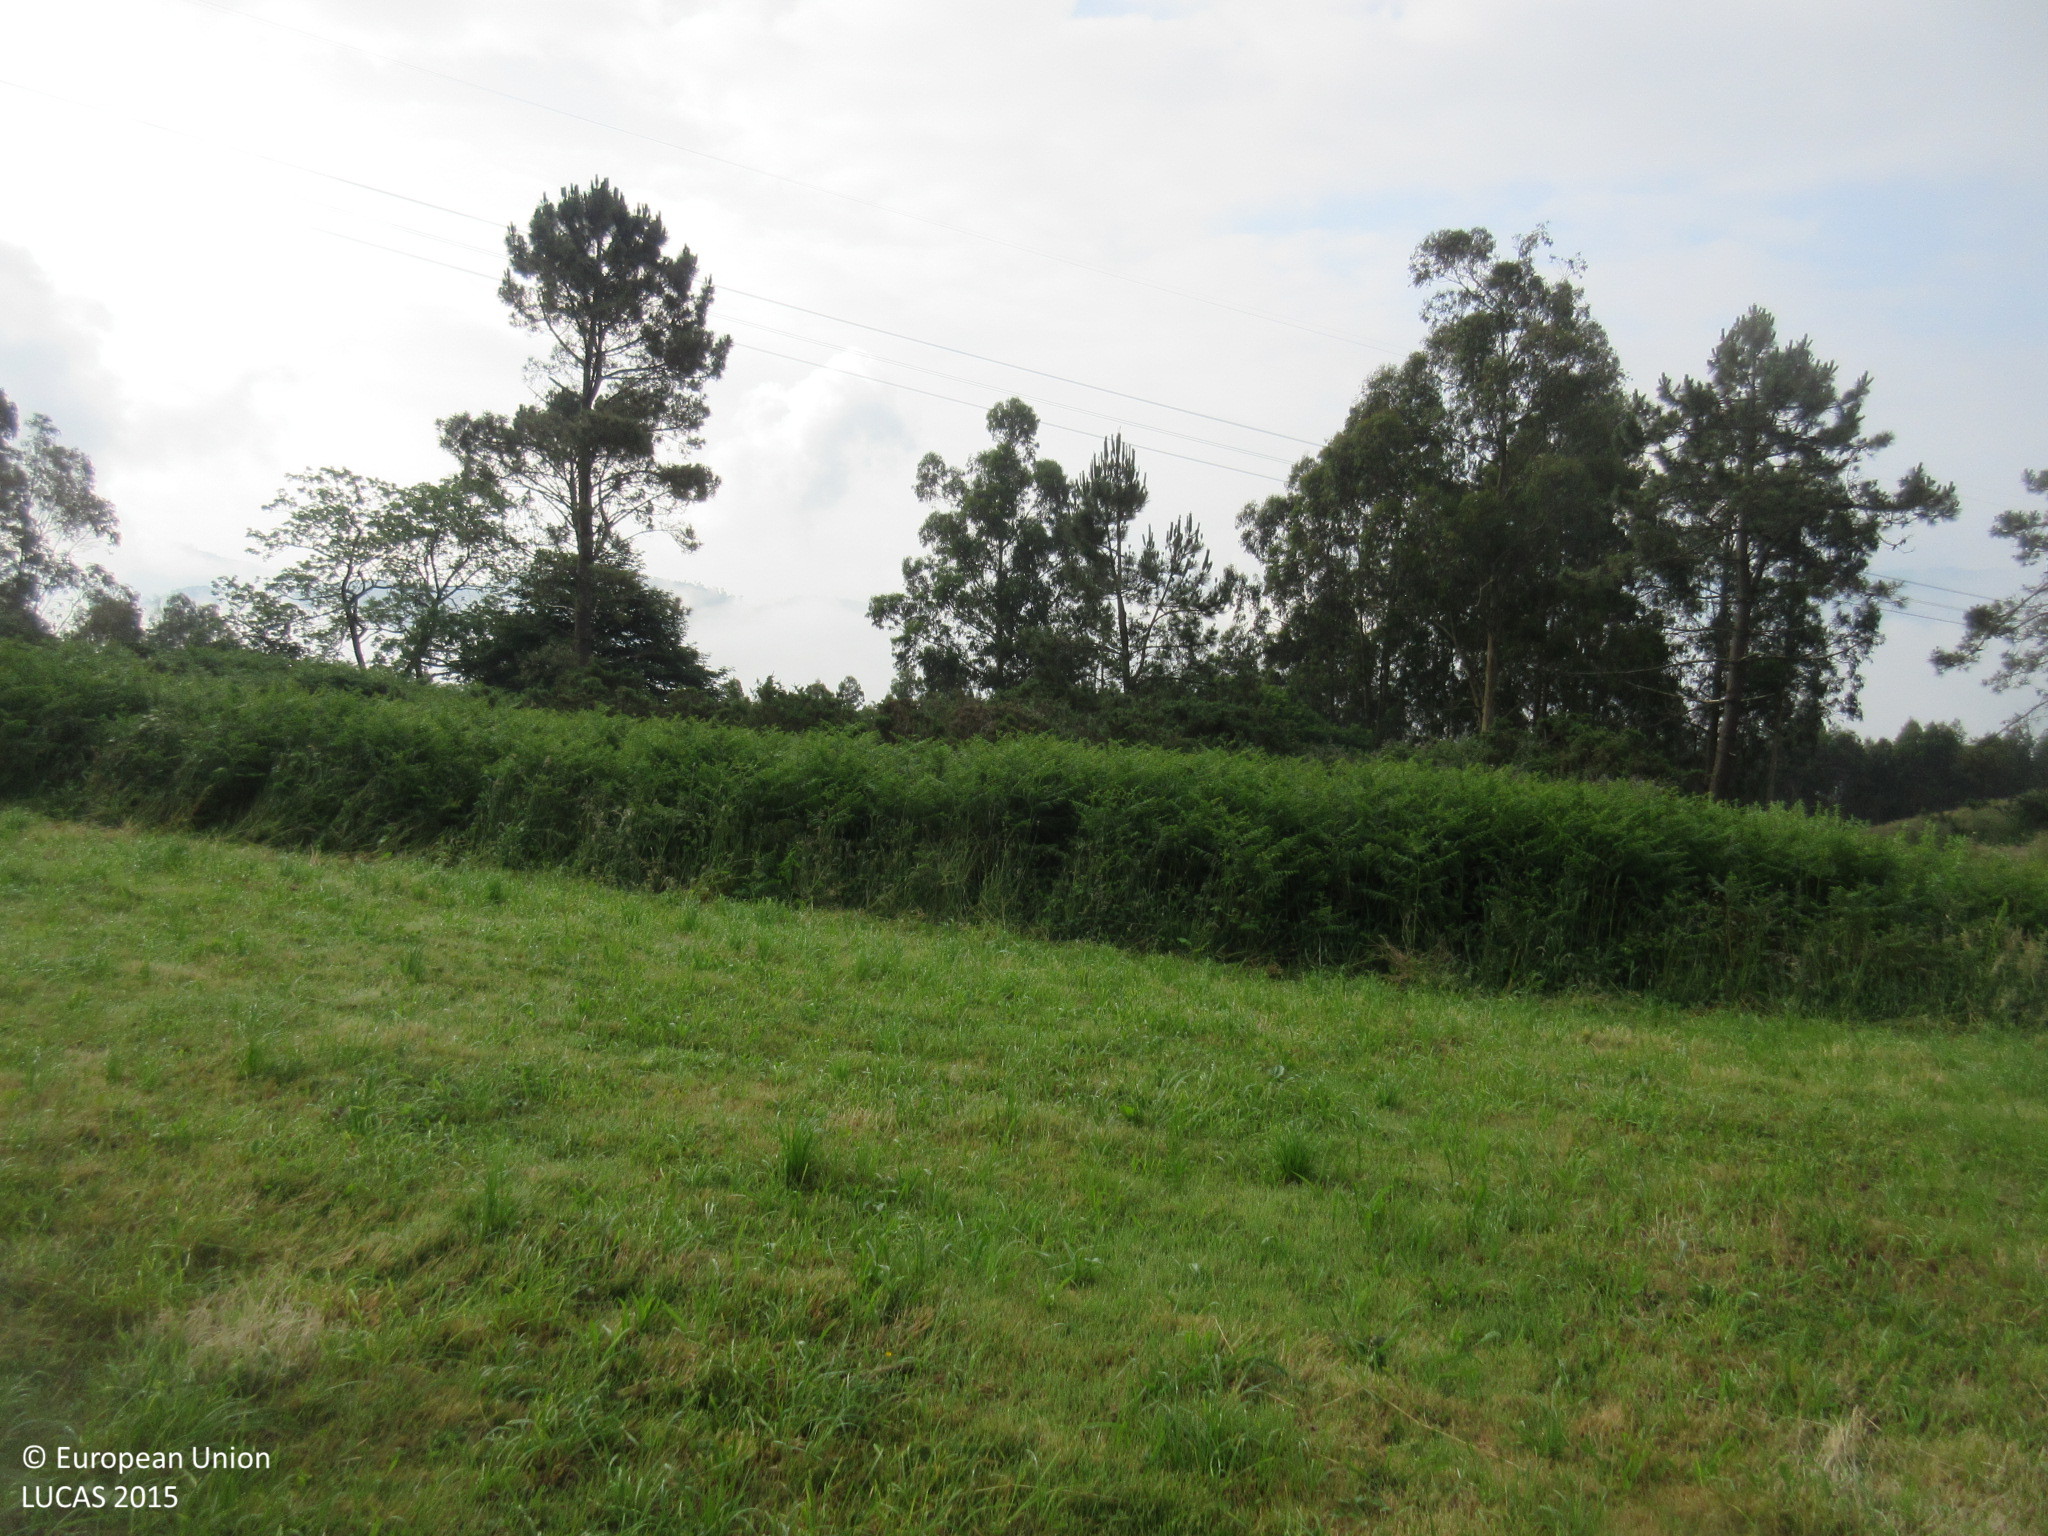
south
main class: Grassland
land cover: Grassland without tree/shrub cover
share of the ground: > 75 %
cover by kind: herbaceous plants 100 %
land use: Agriculture (excluding fallow land and kitchen gardens)
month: June
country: ES
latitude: 43.4642
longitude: -5.8986
